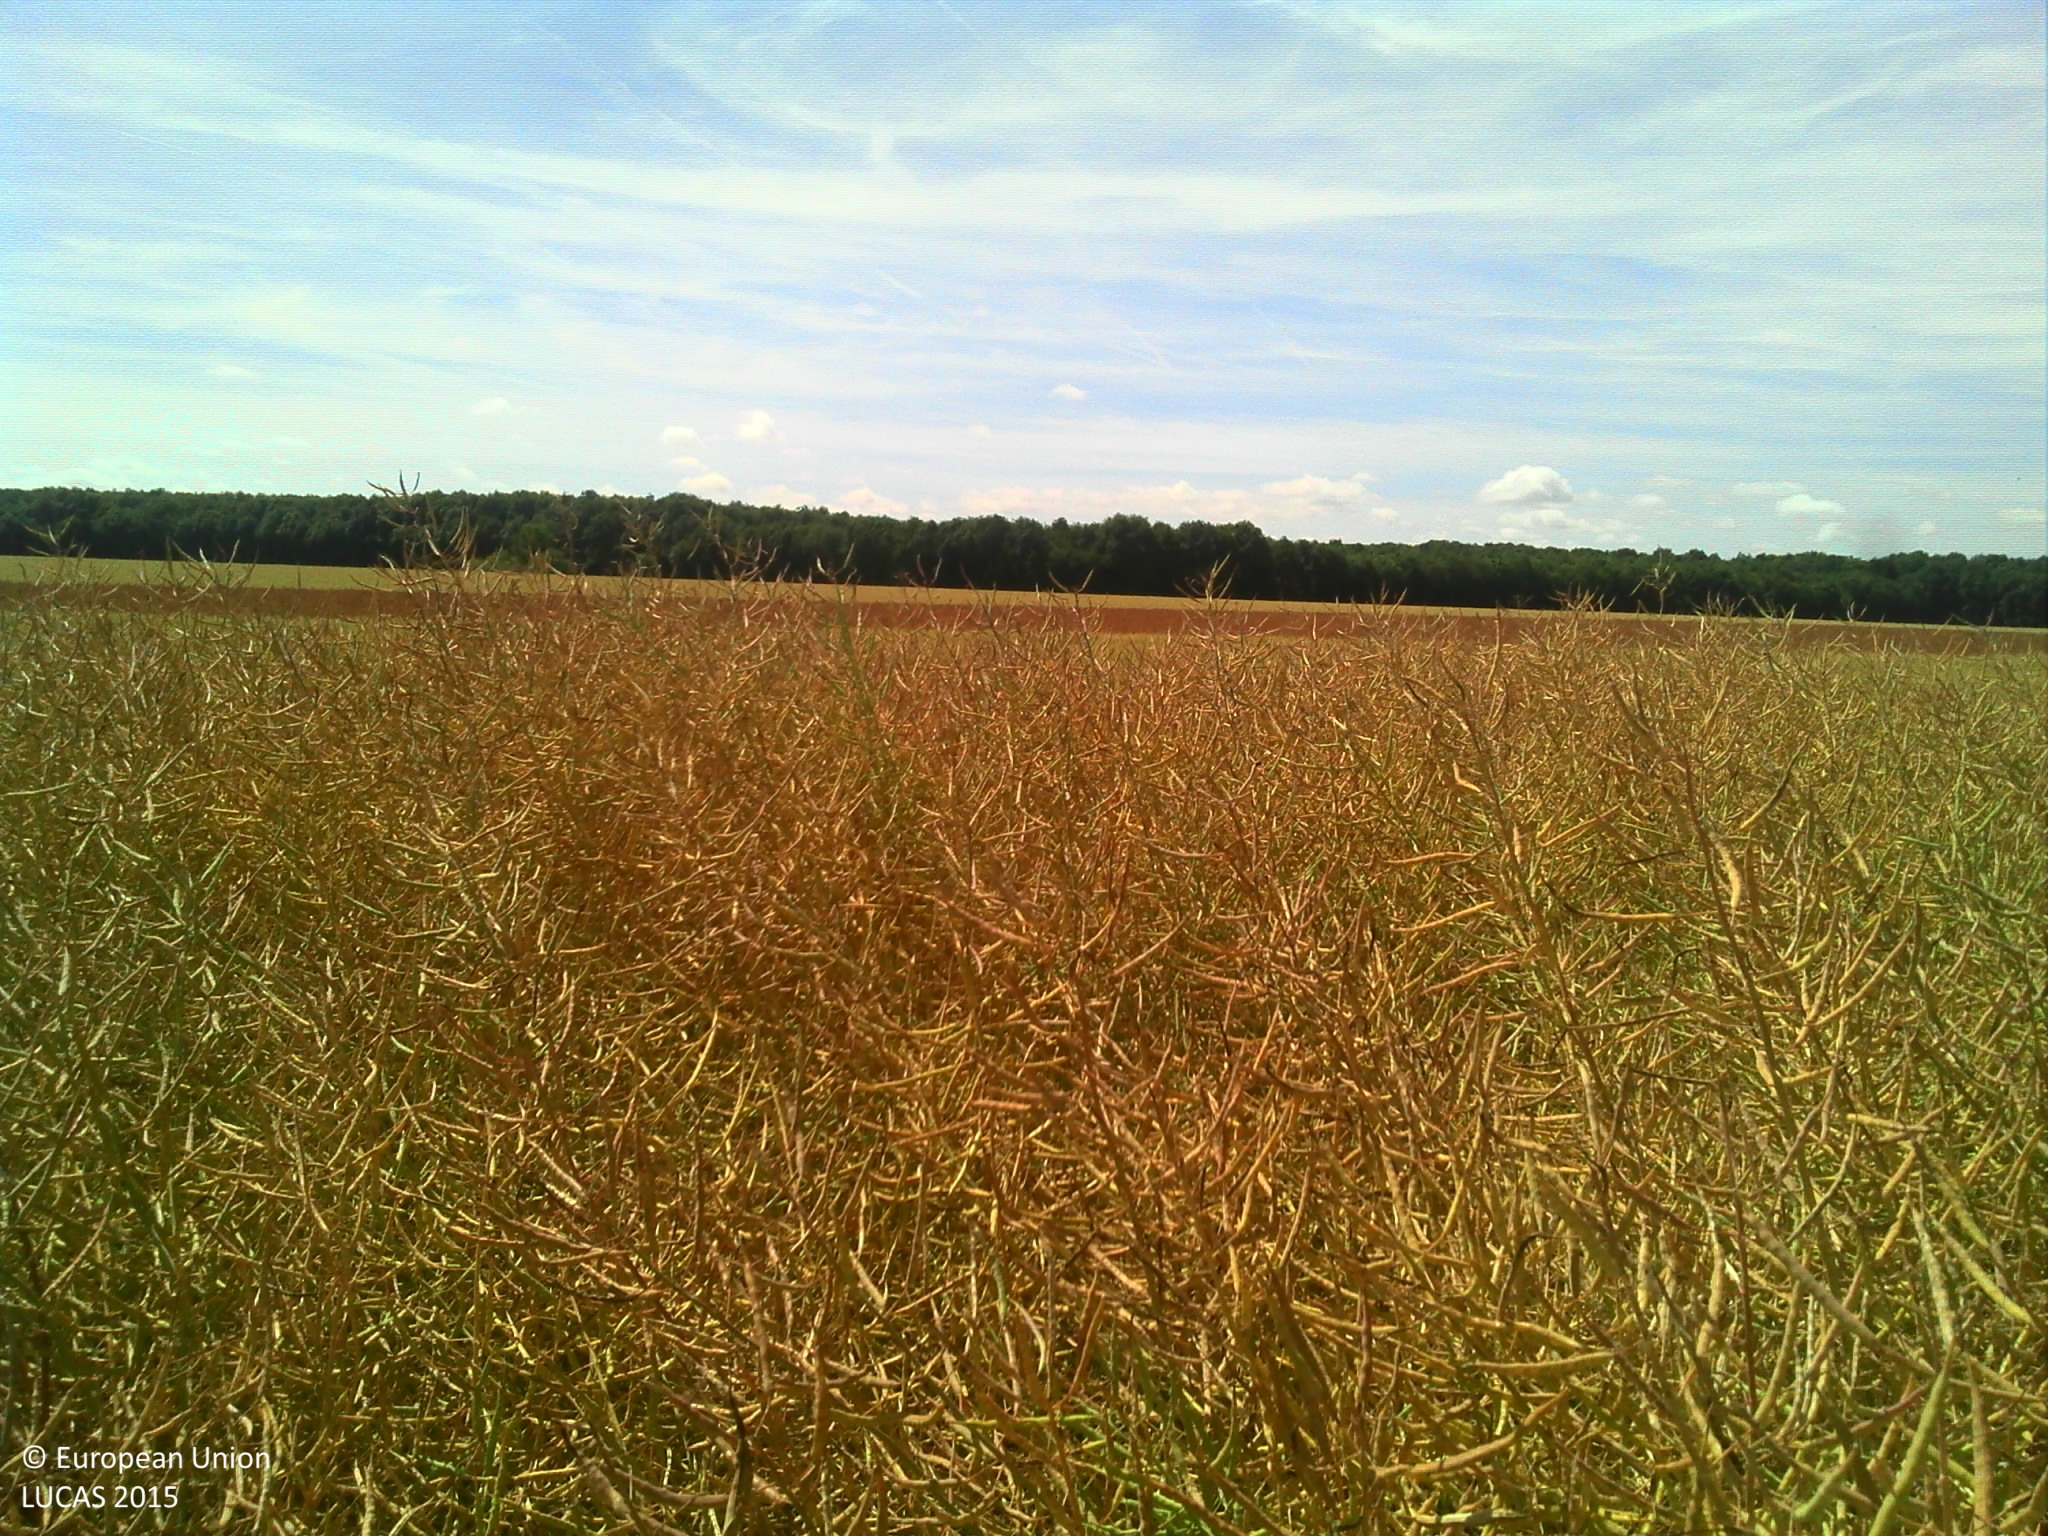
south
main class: Cropland
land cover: Rape and turnip rape
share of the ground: > 75 %
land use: Agriculture (excluding fallow land and kitchen gardens)
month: June
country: FR
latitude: 48.6313
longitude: 1.2017
